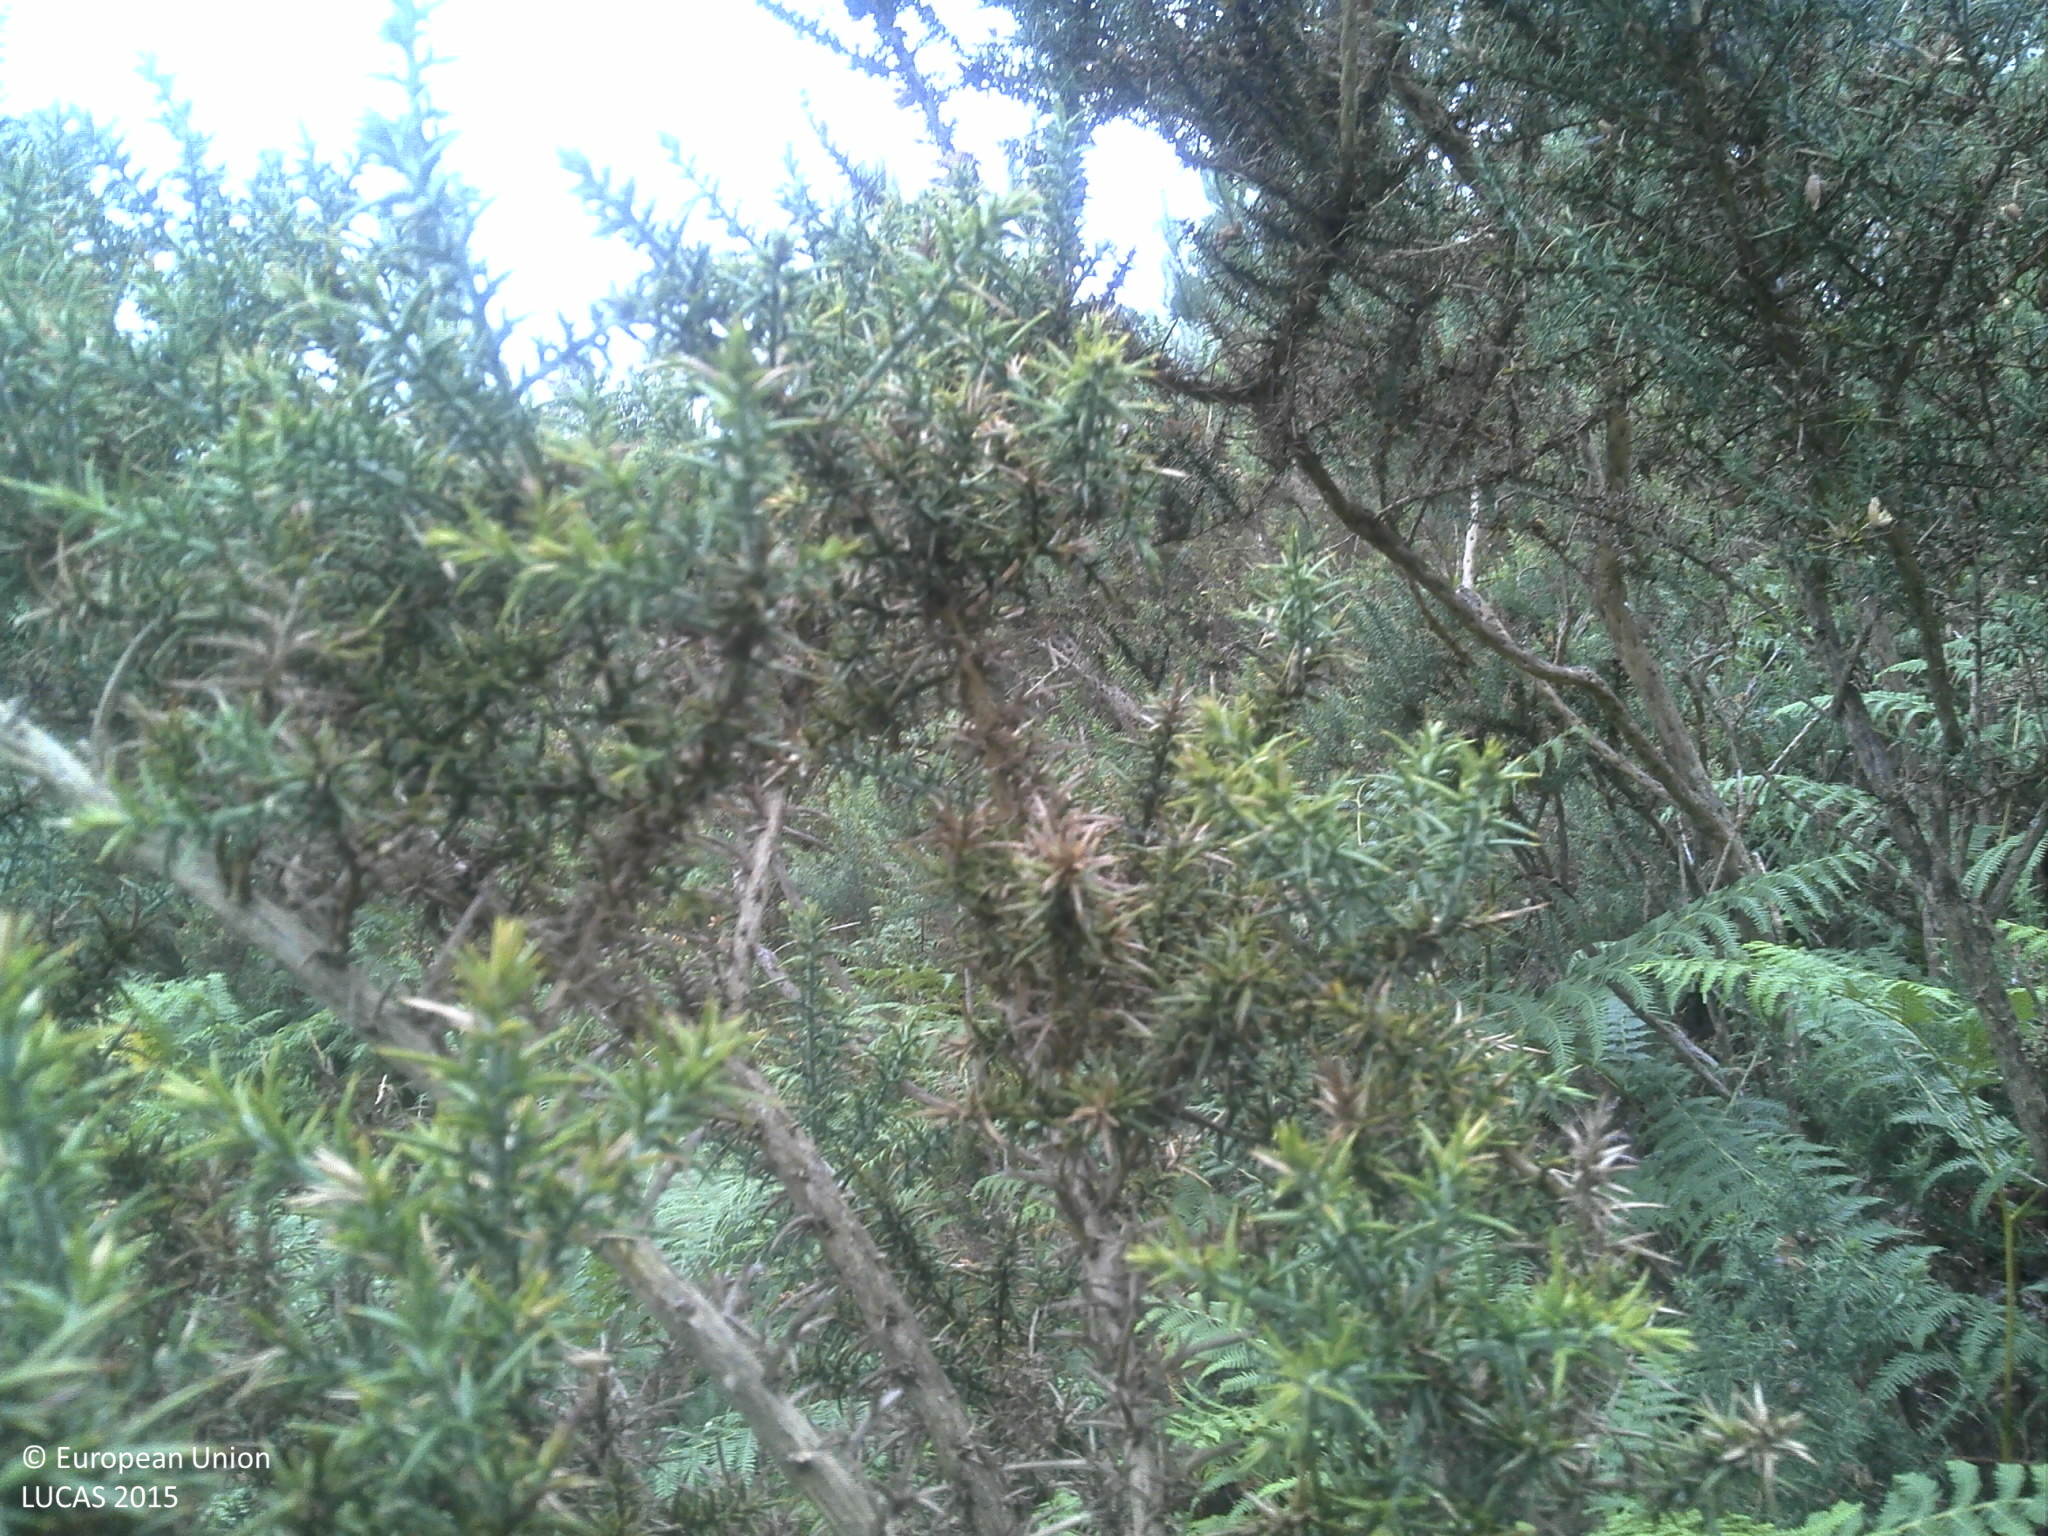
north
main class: Shrubland
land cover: Shrubland without tree cover
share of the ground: > 75 %
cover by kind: shrubs 90 %, herbaceous plants 10 %
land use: Forestry
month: June
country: PT
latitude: 41.2390
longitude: -8.2438
